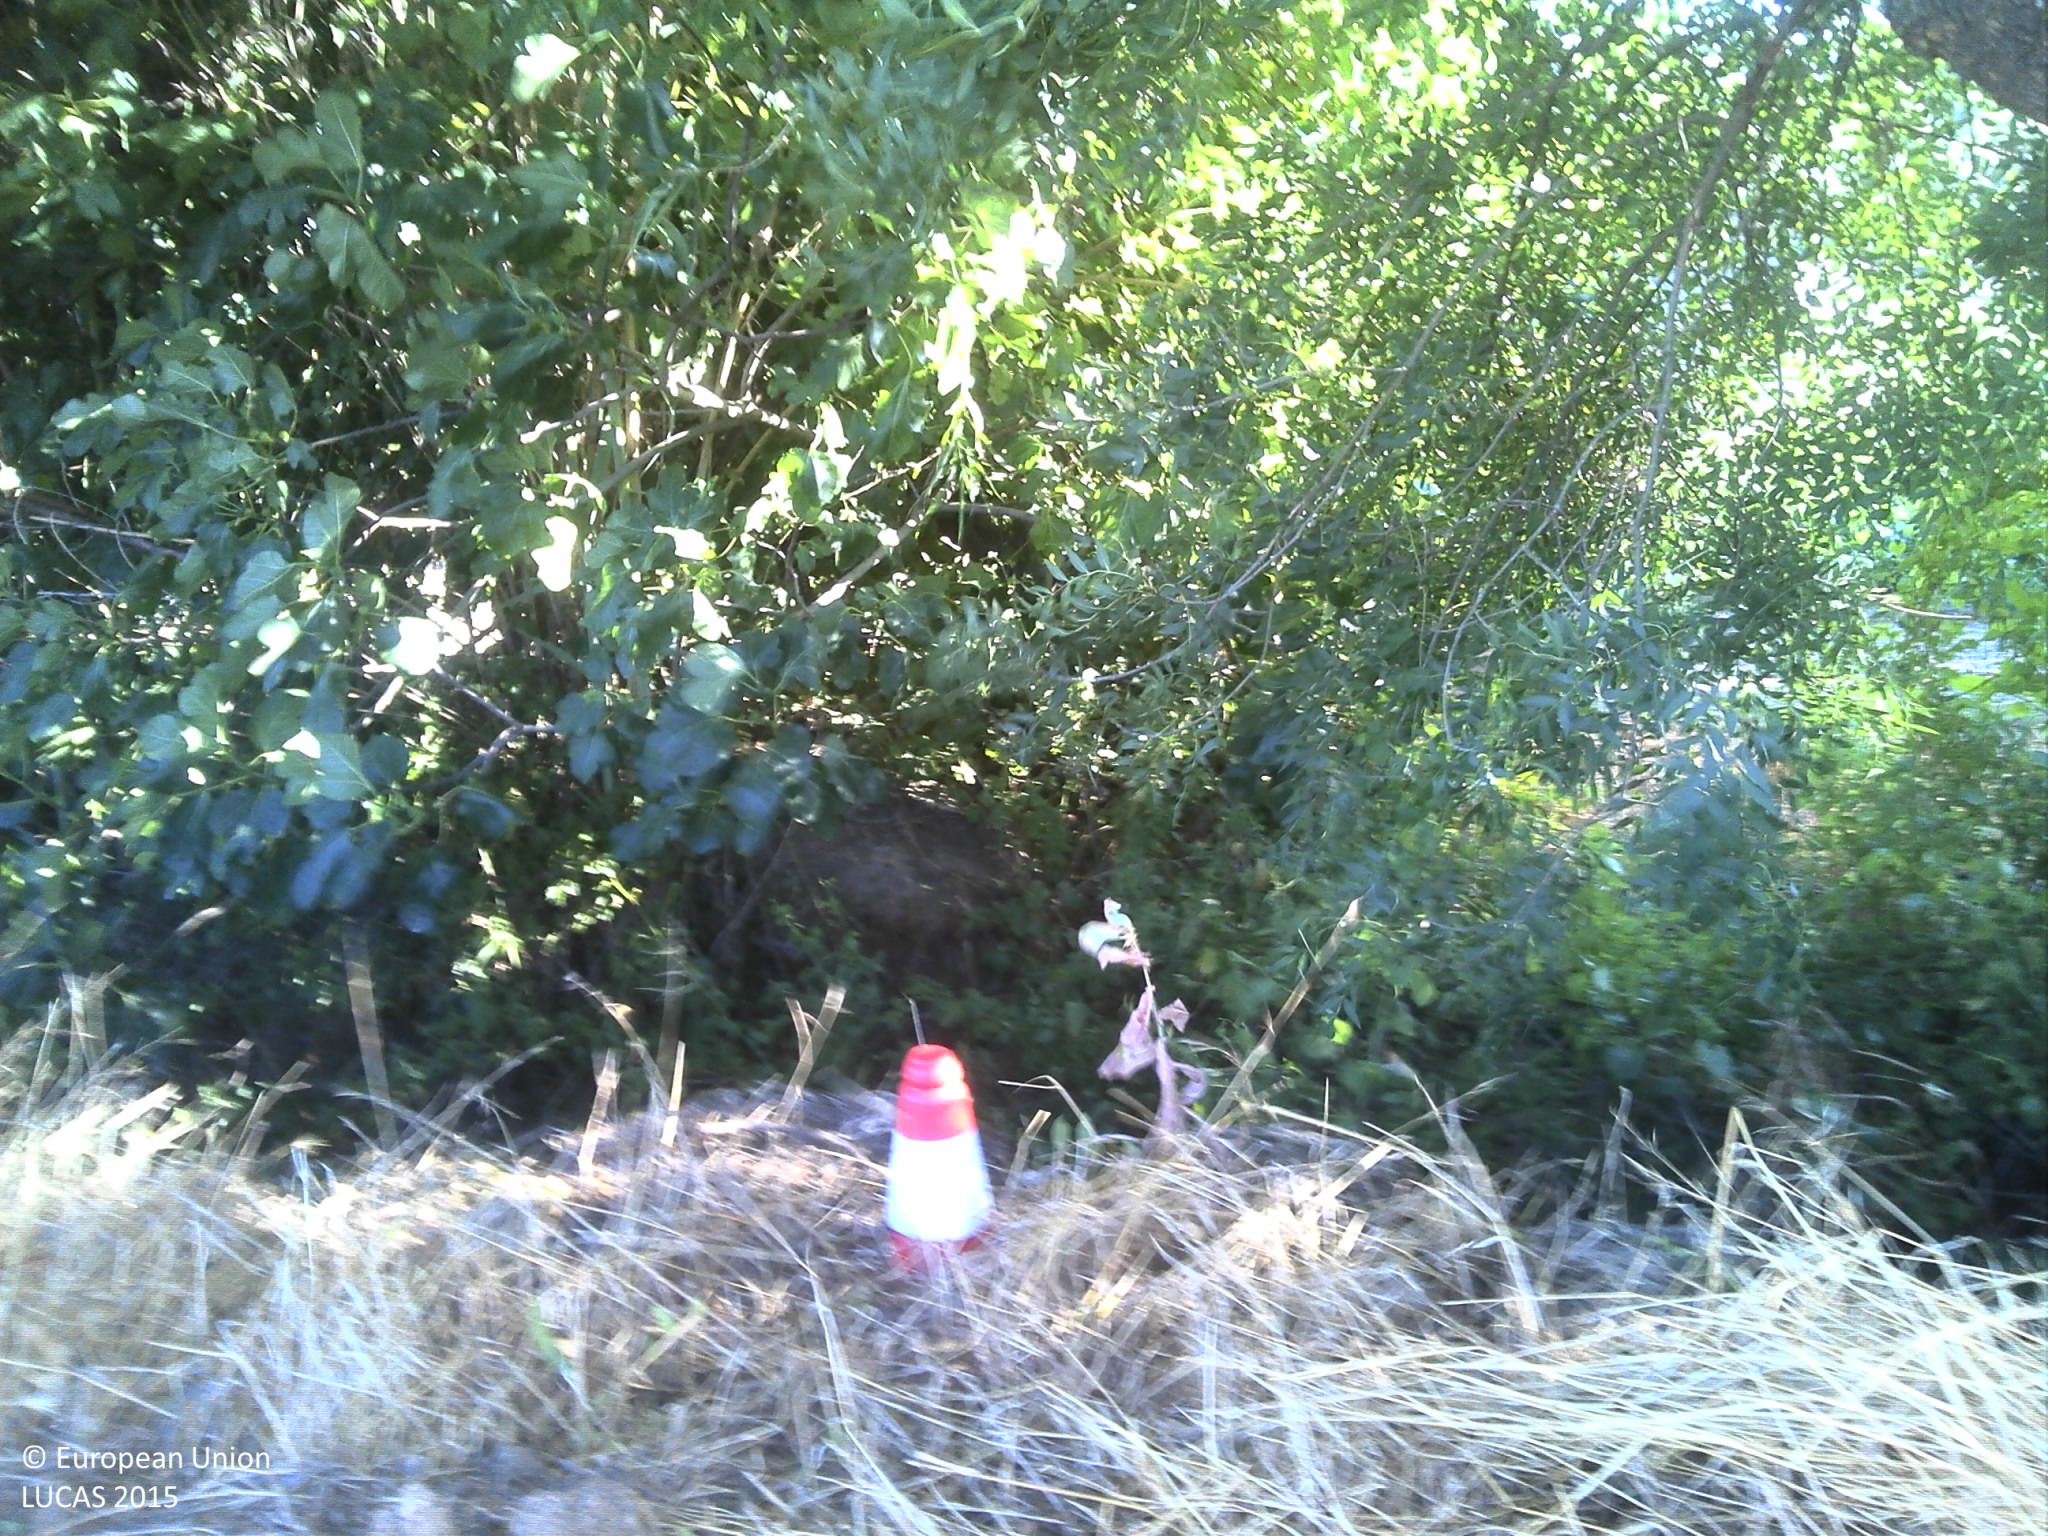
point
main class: Cropland
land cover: Vineyards
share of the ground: 10 - 25 %
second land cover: Other bare soil
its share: > 75 %
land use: Agriculture (excluding fallow land and kitchen gardens)
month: July
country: PT
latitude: 40.3198
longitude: -7.4171
